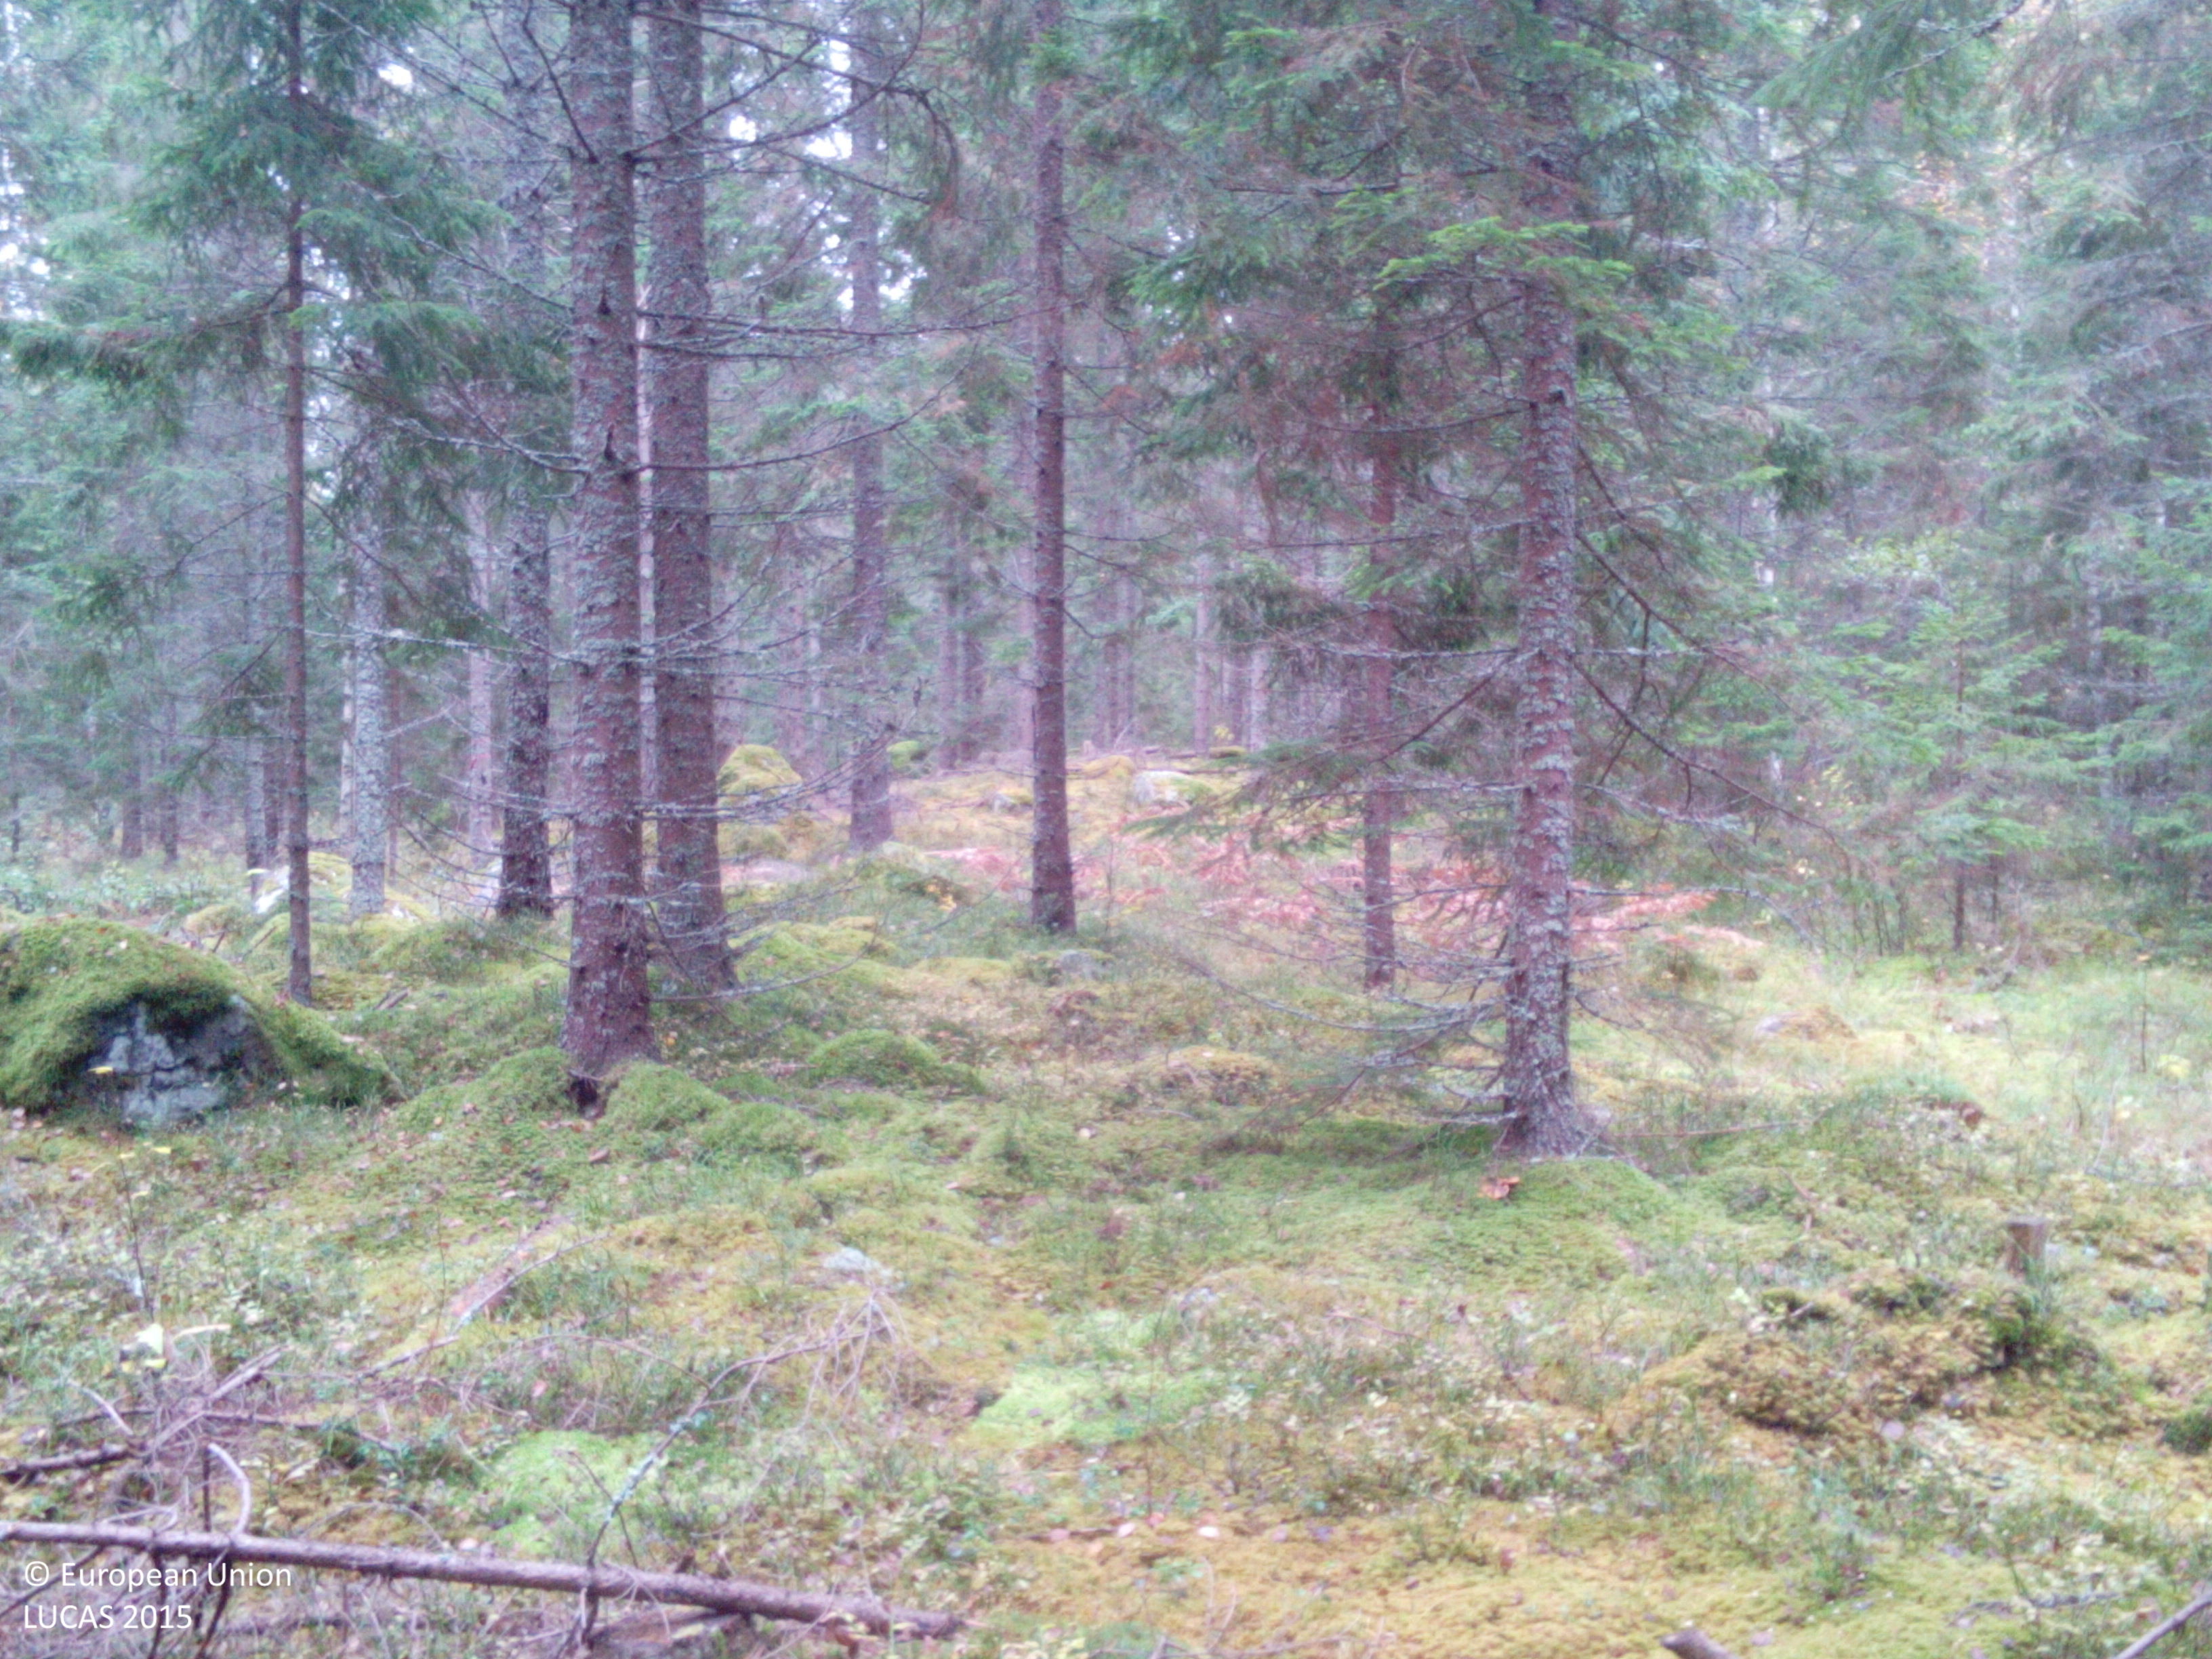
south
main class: Woodland
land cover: Spruce dominated coniferous woodland
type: boreal forest
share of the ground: > 75 %
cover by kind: coniferous forest trees 85 %, lichens and mosses 10 %, herbaceous plants 5 %
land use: Forestry
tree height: > 5 m
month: October
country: SE
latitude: 59.1937
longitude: 16.2427
